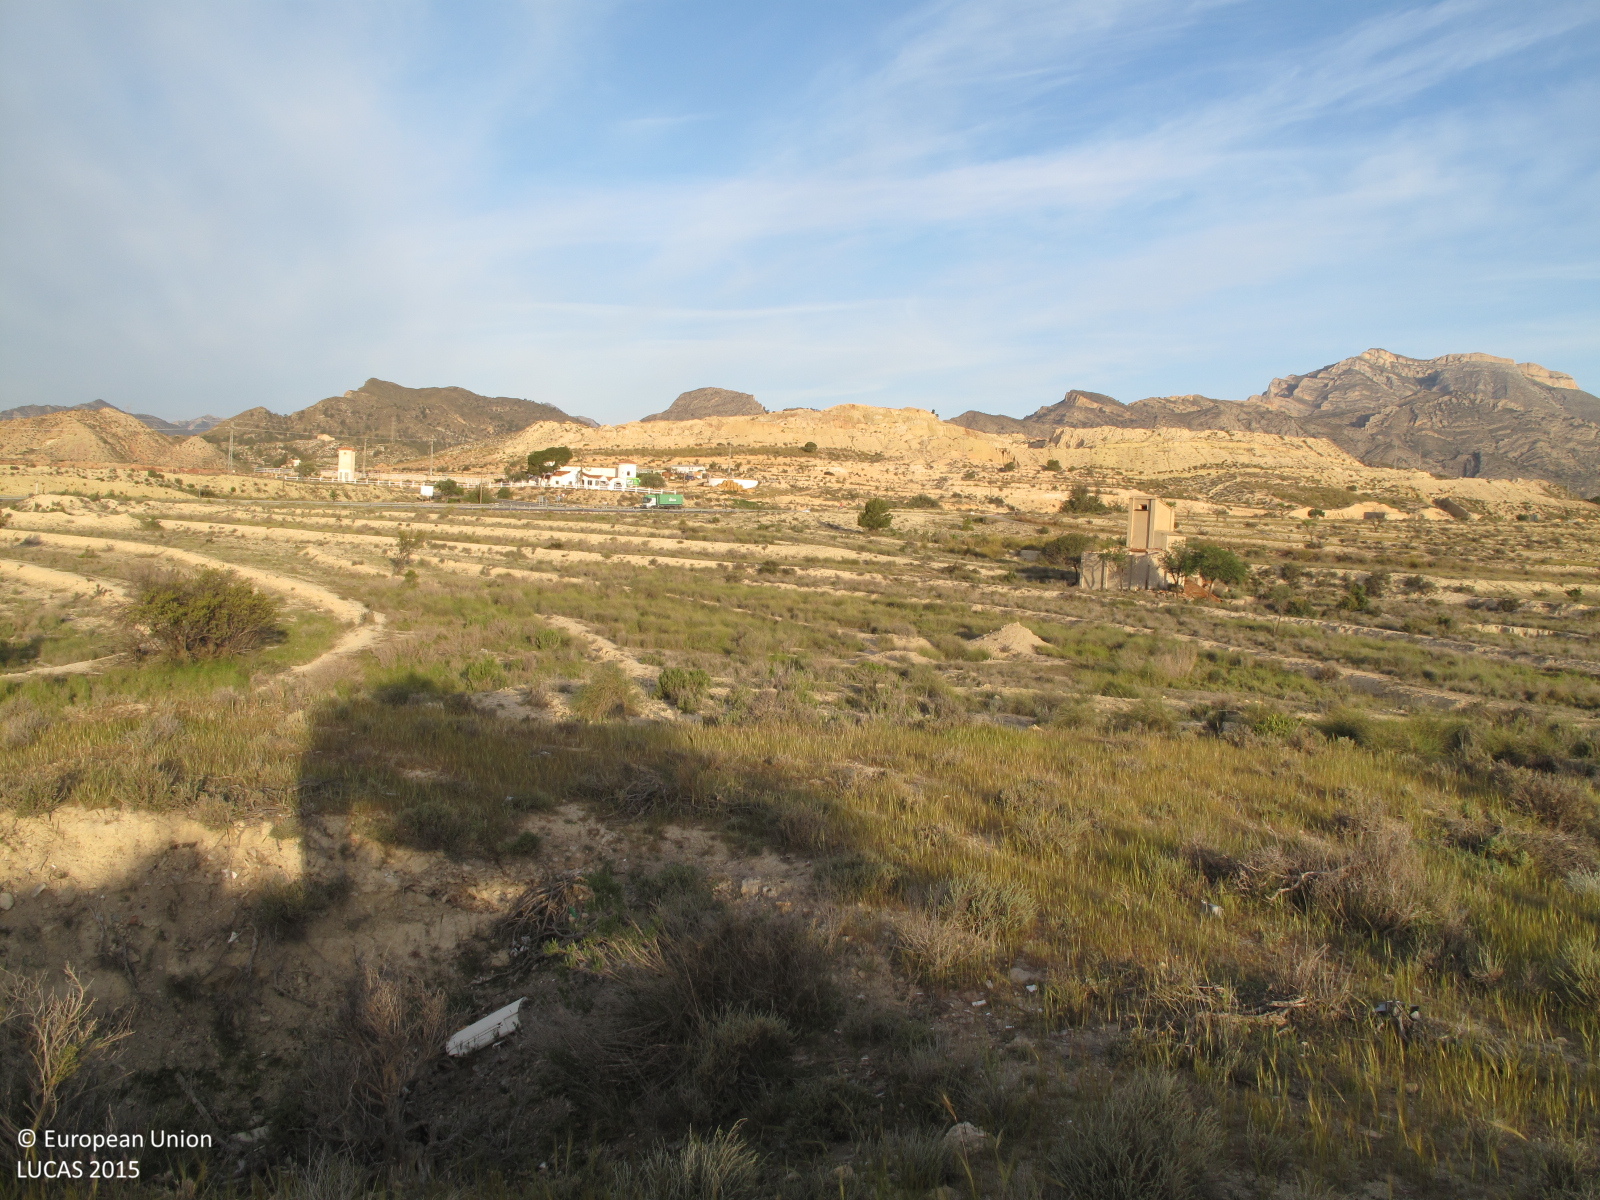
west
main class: Shrubland
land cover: Shrubland with sparse tree cover
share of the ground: 10 - 25 %
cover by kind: consolidated bare surface 75 %, shrubs 10 %, herbaceous plants 10 %, coniferous forest trees 5 %
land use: Semi-natural and natural areas not in use
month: April
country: ES
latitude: 38.5005
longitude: -0.4790
